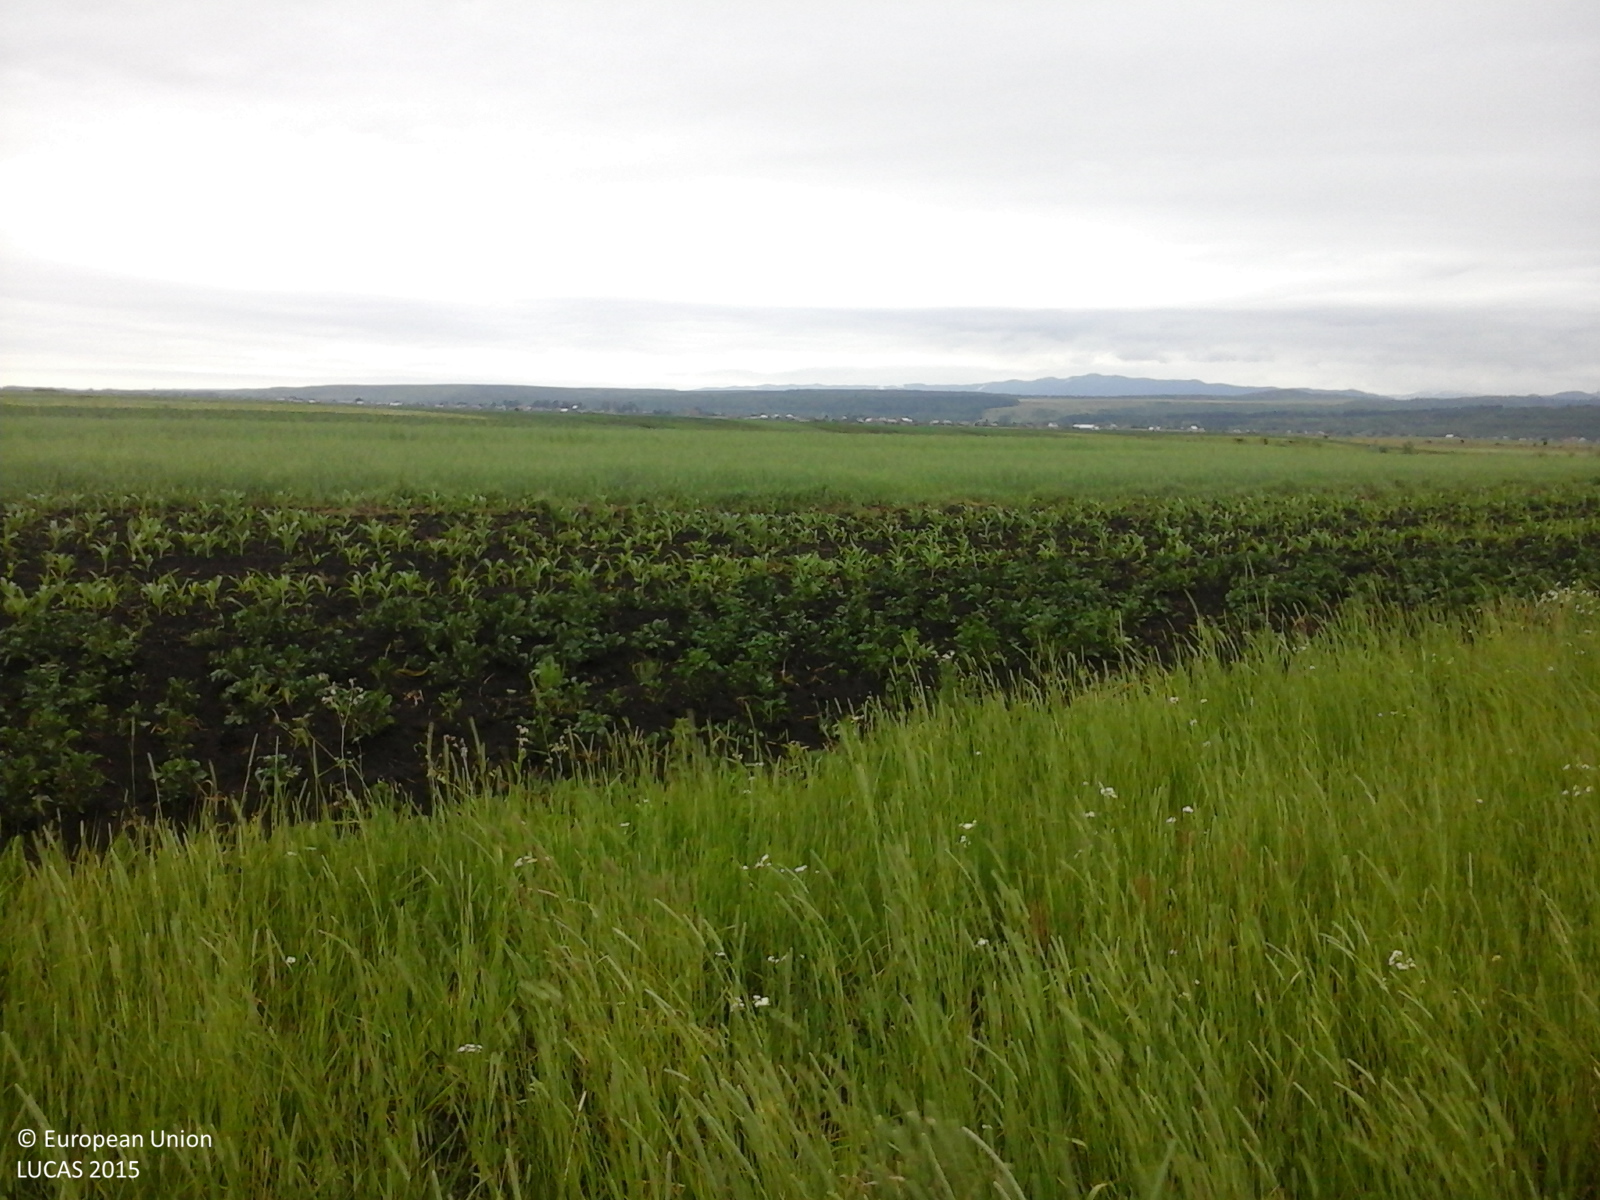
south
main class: Grassland
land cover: Grassland without tree/shrub cover
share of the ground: > 75 %
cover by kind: herbaceous plants 100 %
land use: Agriculture (excluding fallow land and kitchen gardens)
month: June
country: RO
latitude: 47.4557
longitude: 26.1963
